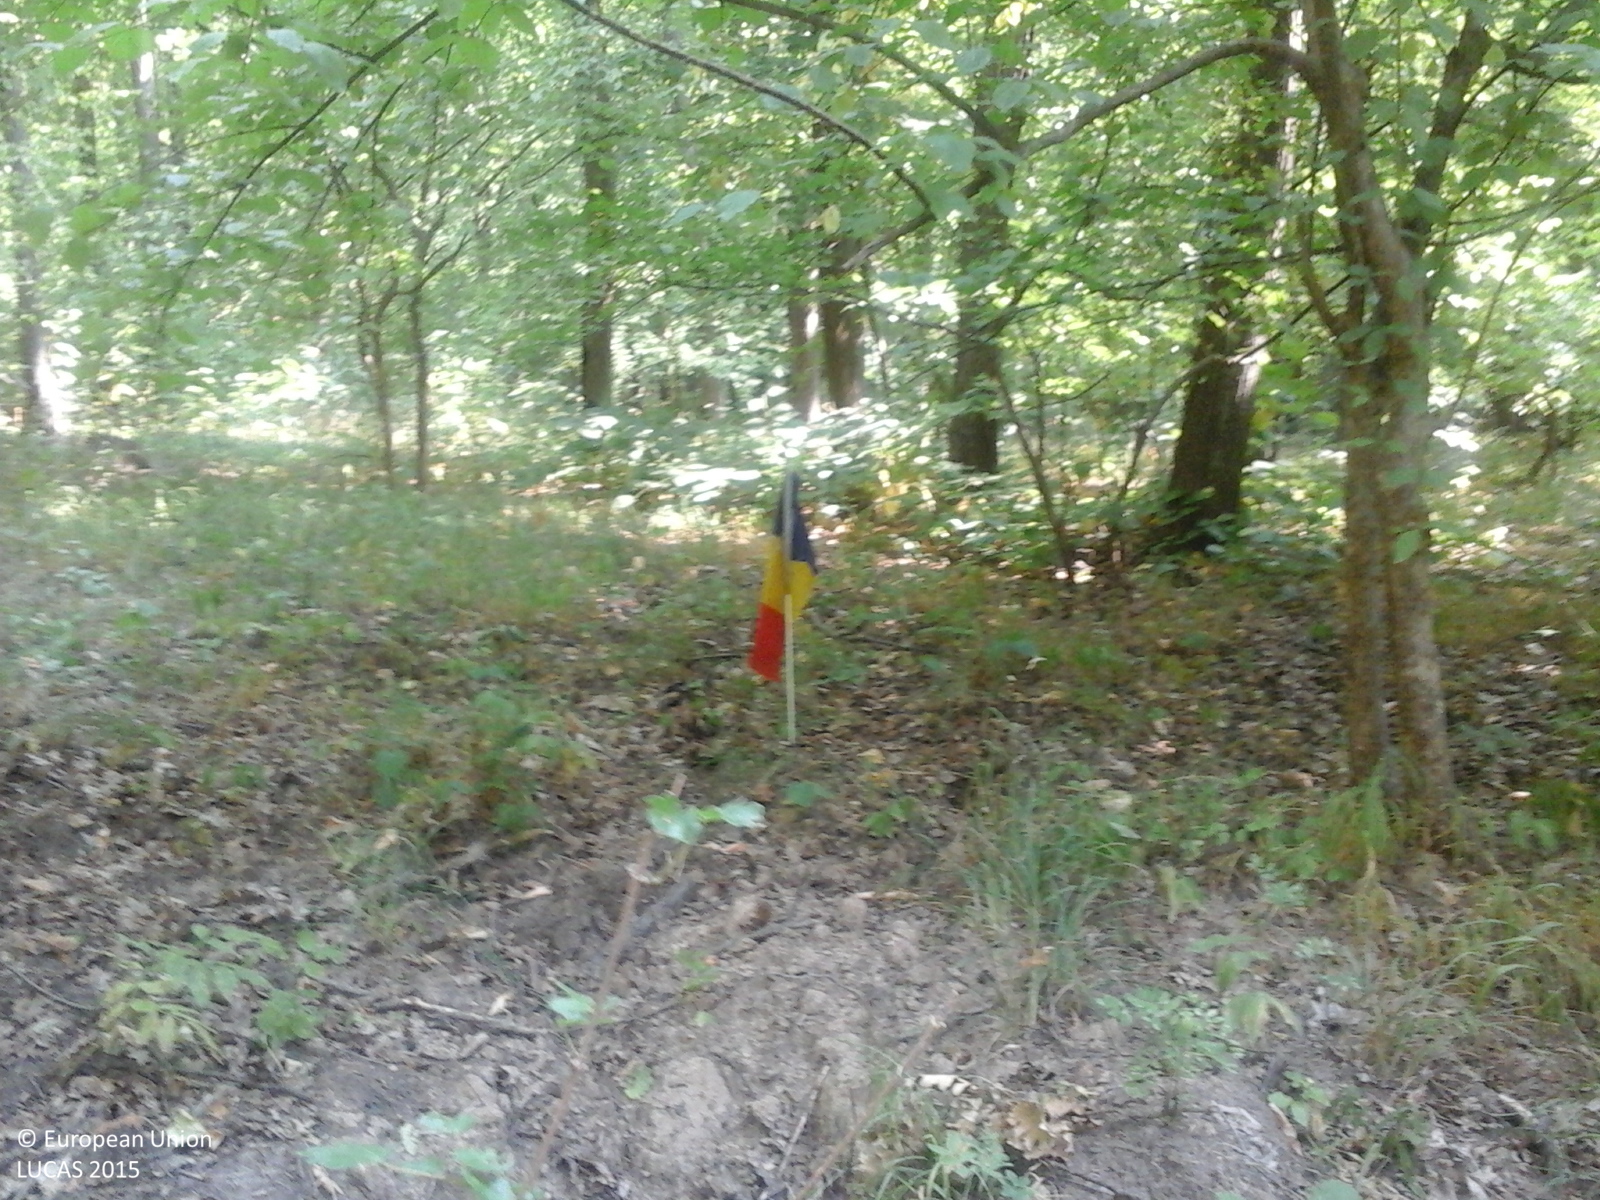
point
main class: Woodland
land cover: Broadleaved woodland
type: acidophilous oak and oak-birch forest
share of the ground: > 75 %
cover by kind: broadleaved forest trees 95 %, herbaceous plants 5 %
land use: Forestry
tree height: > 5 m
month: July
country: RO
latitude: 46.4523
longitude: 27.6514
